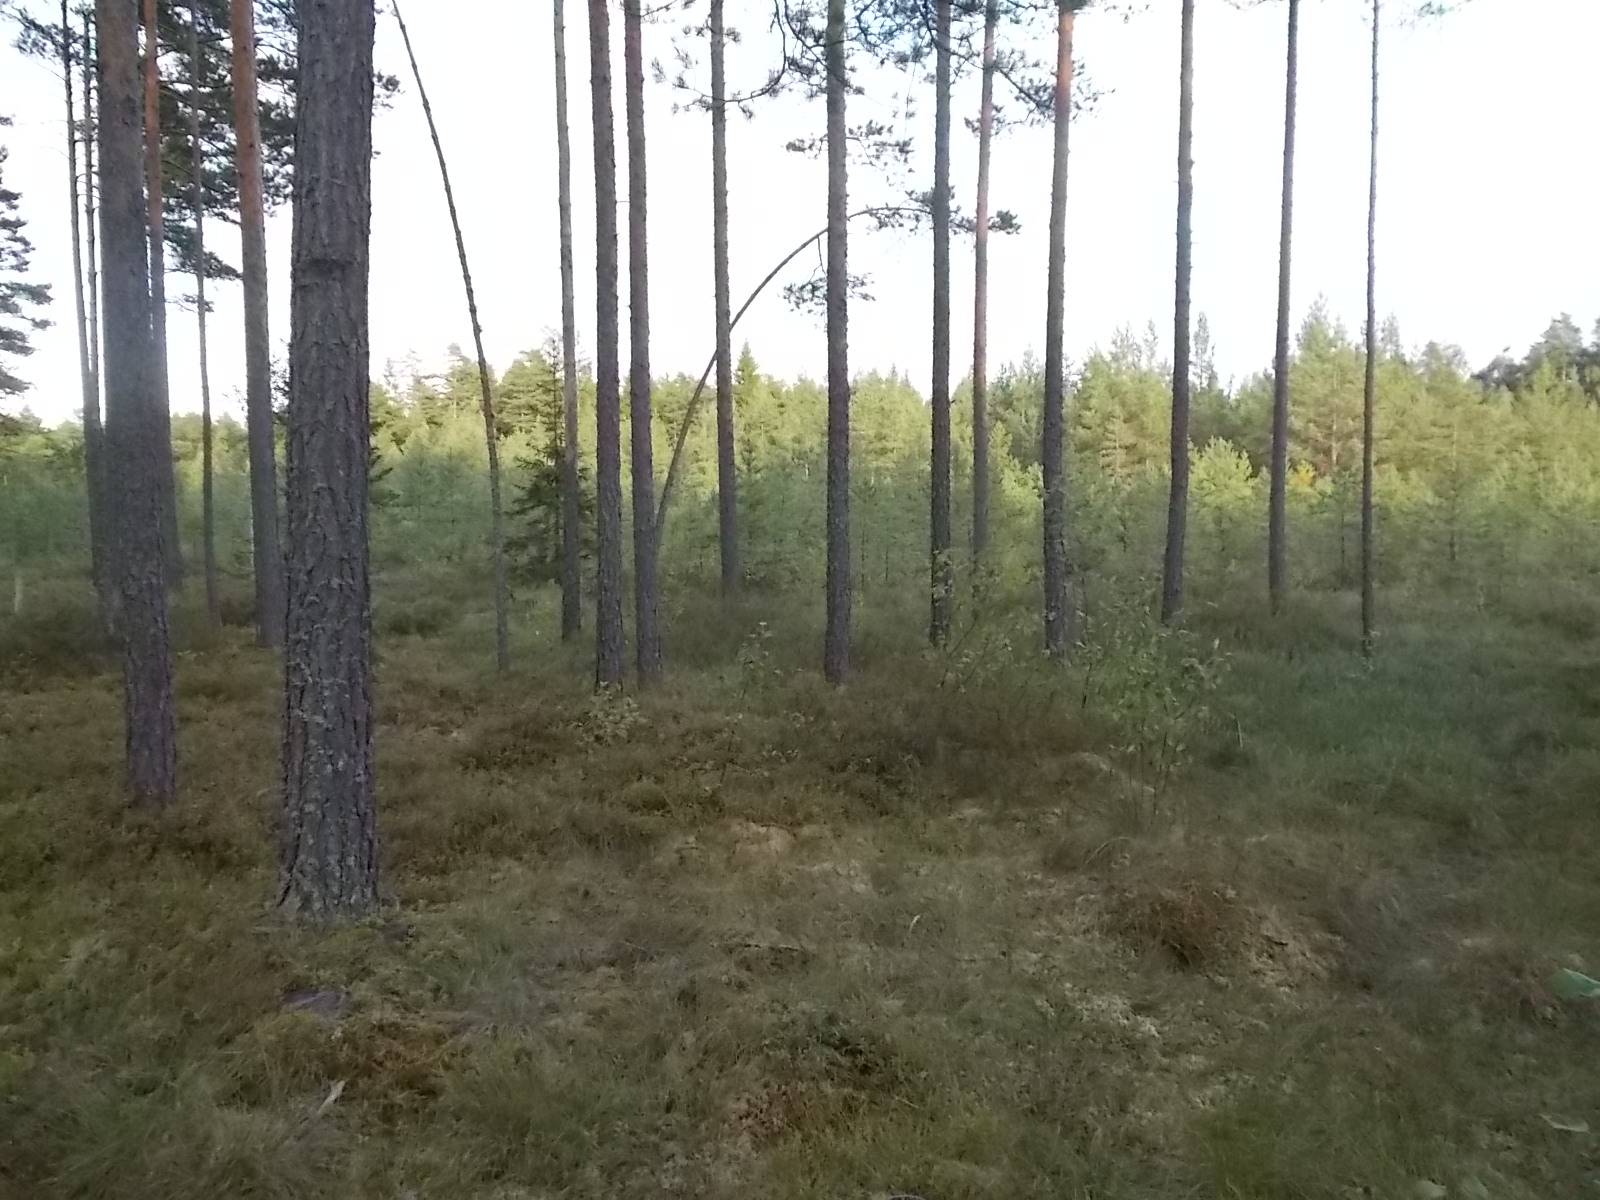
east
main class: Woodland
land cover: Pine dominated coniferous woodland
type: hemiboreal forest and nemoral coniferous forest and mixed broadleaved-coniferous forest
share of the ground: 25 - 50 %
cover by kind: coniferous forest trees 40 %, herbaceous plants 30 %, broadleaved forest trees 10 %, shrubs 10 %, lichens and mosses 10 %
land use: Forestry
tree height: > 5 m
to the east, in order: Pine dominated coniferous woodland; Other coniferous woodland
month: September
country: LV
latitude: 57.1752
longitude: 21.9383
